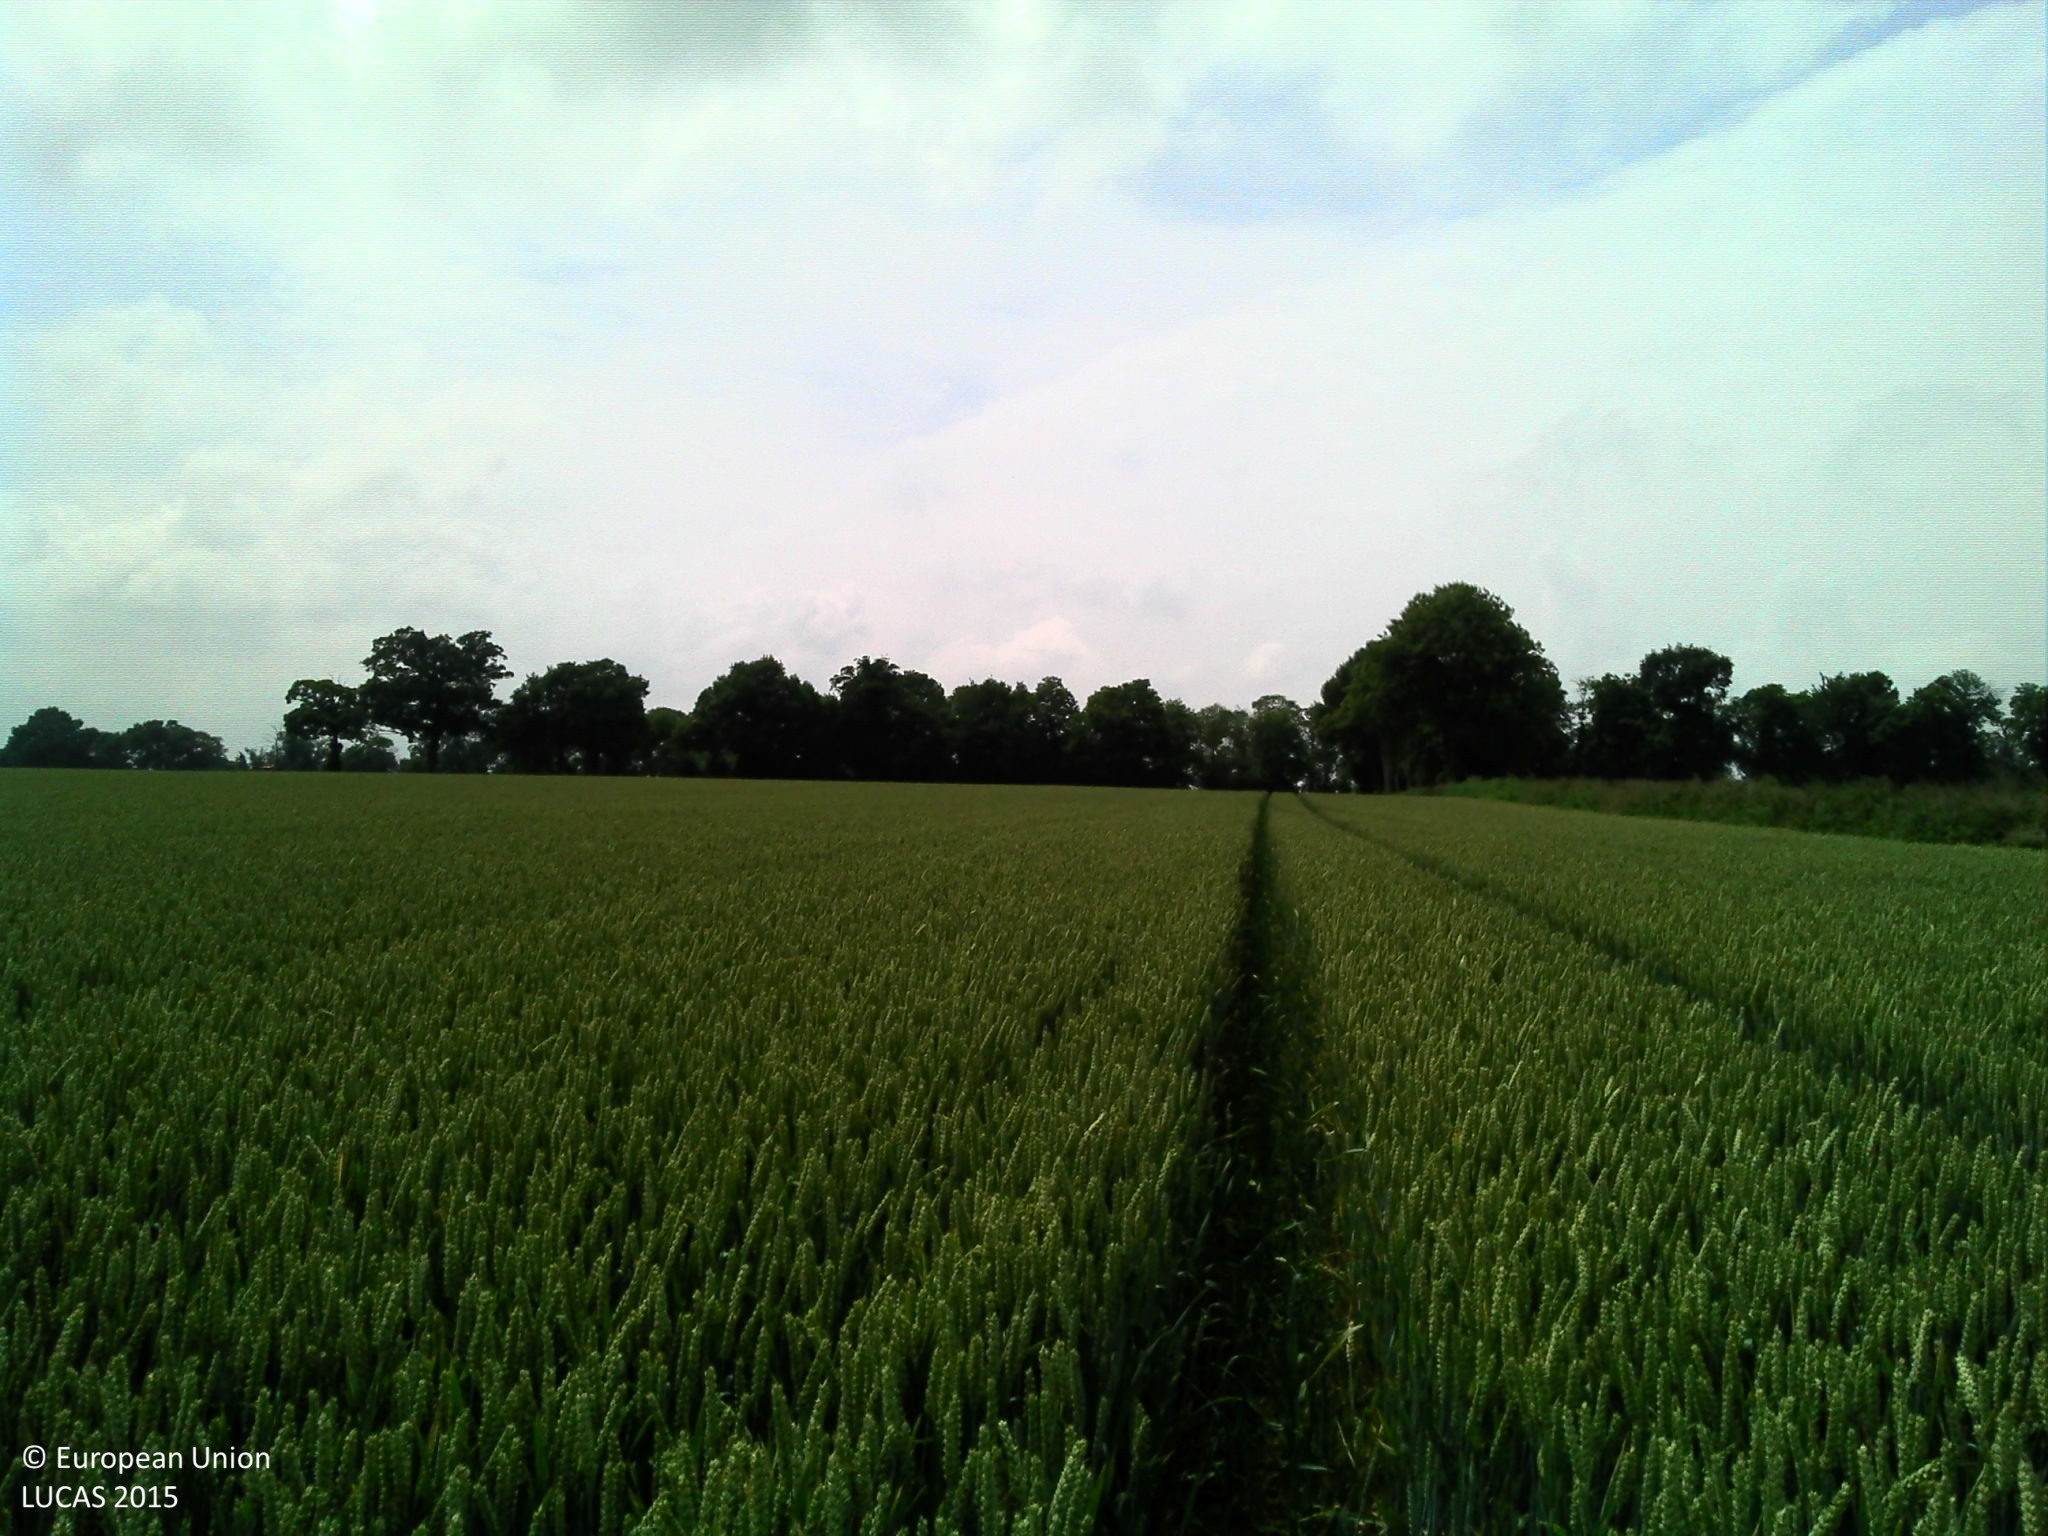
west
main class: Cropland
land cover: Common wheat
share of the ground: > 75 %
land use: Agriculture (excluding fallow land and kitchen gardens)
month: June
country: FR
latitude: 48.5215
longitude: -1.7349
